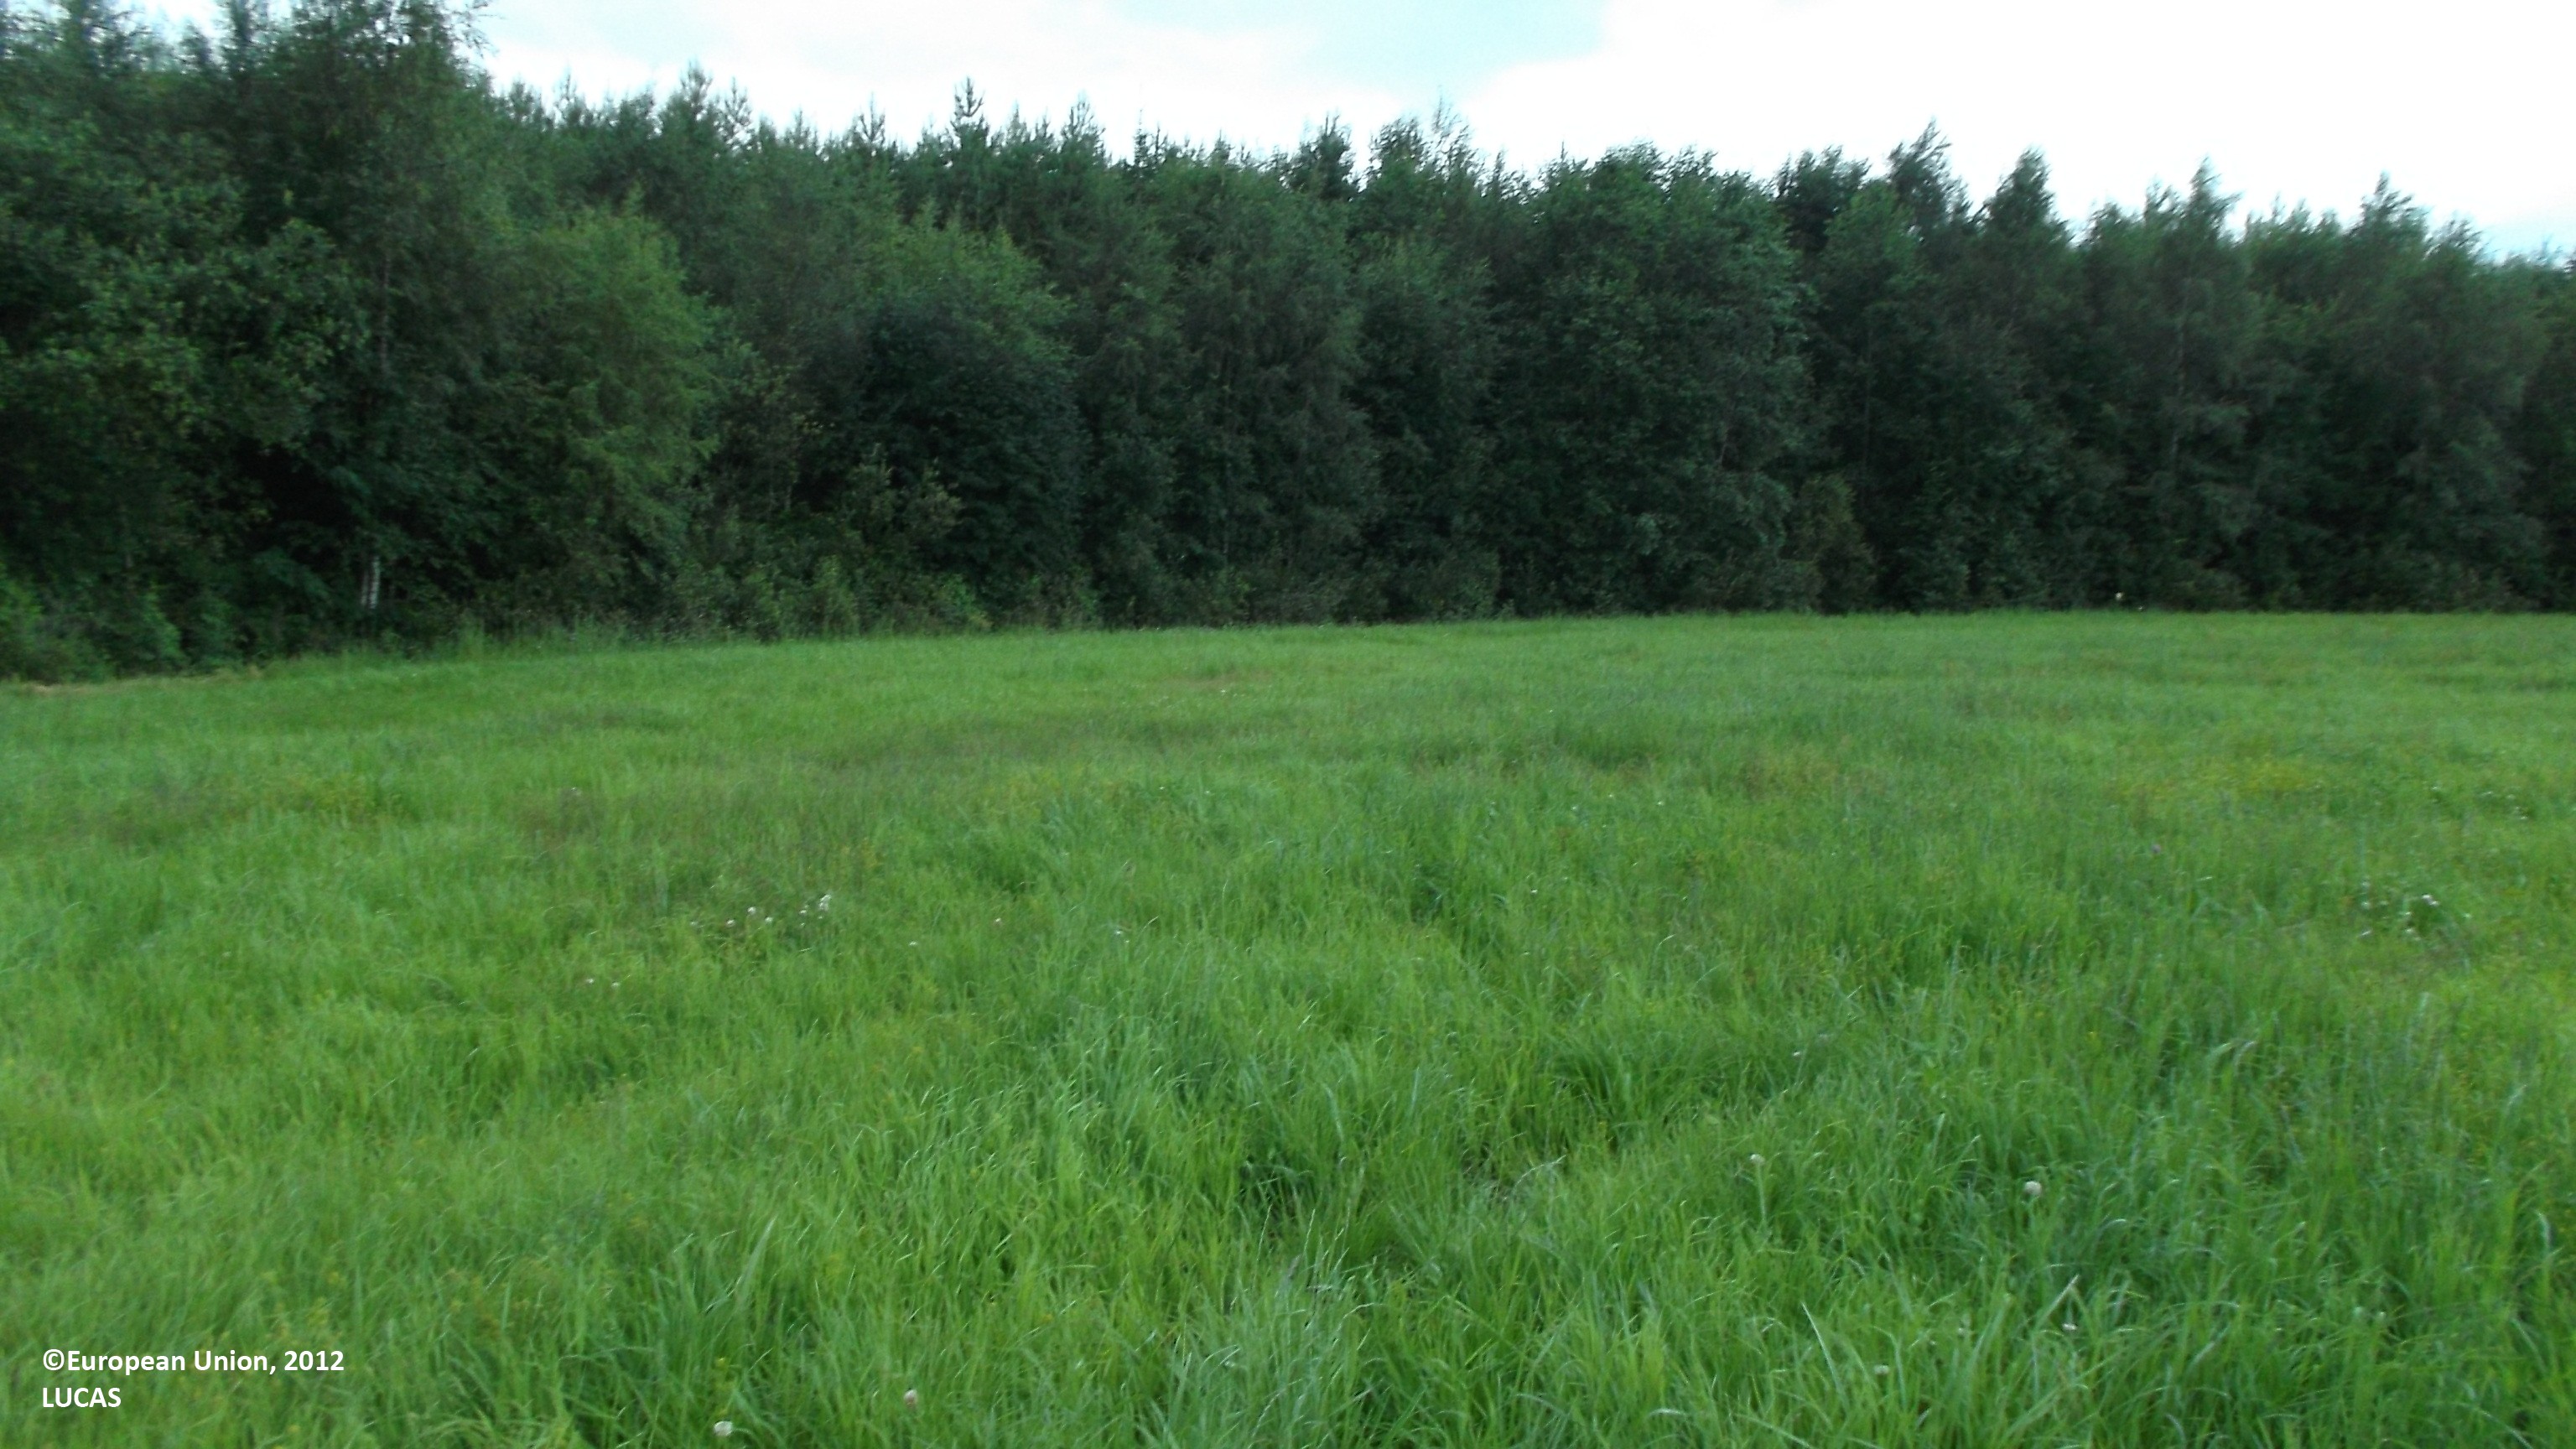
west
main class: Cropland
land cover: Temporary grasslands
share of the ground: > 75 %
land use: Agriculture (excluding fallow land and kitchen gardens)
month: July
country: FI
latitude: 63.6849
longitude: 23.3412
